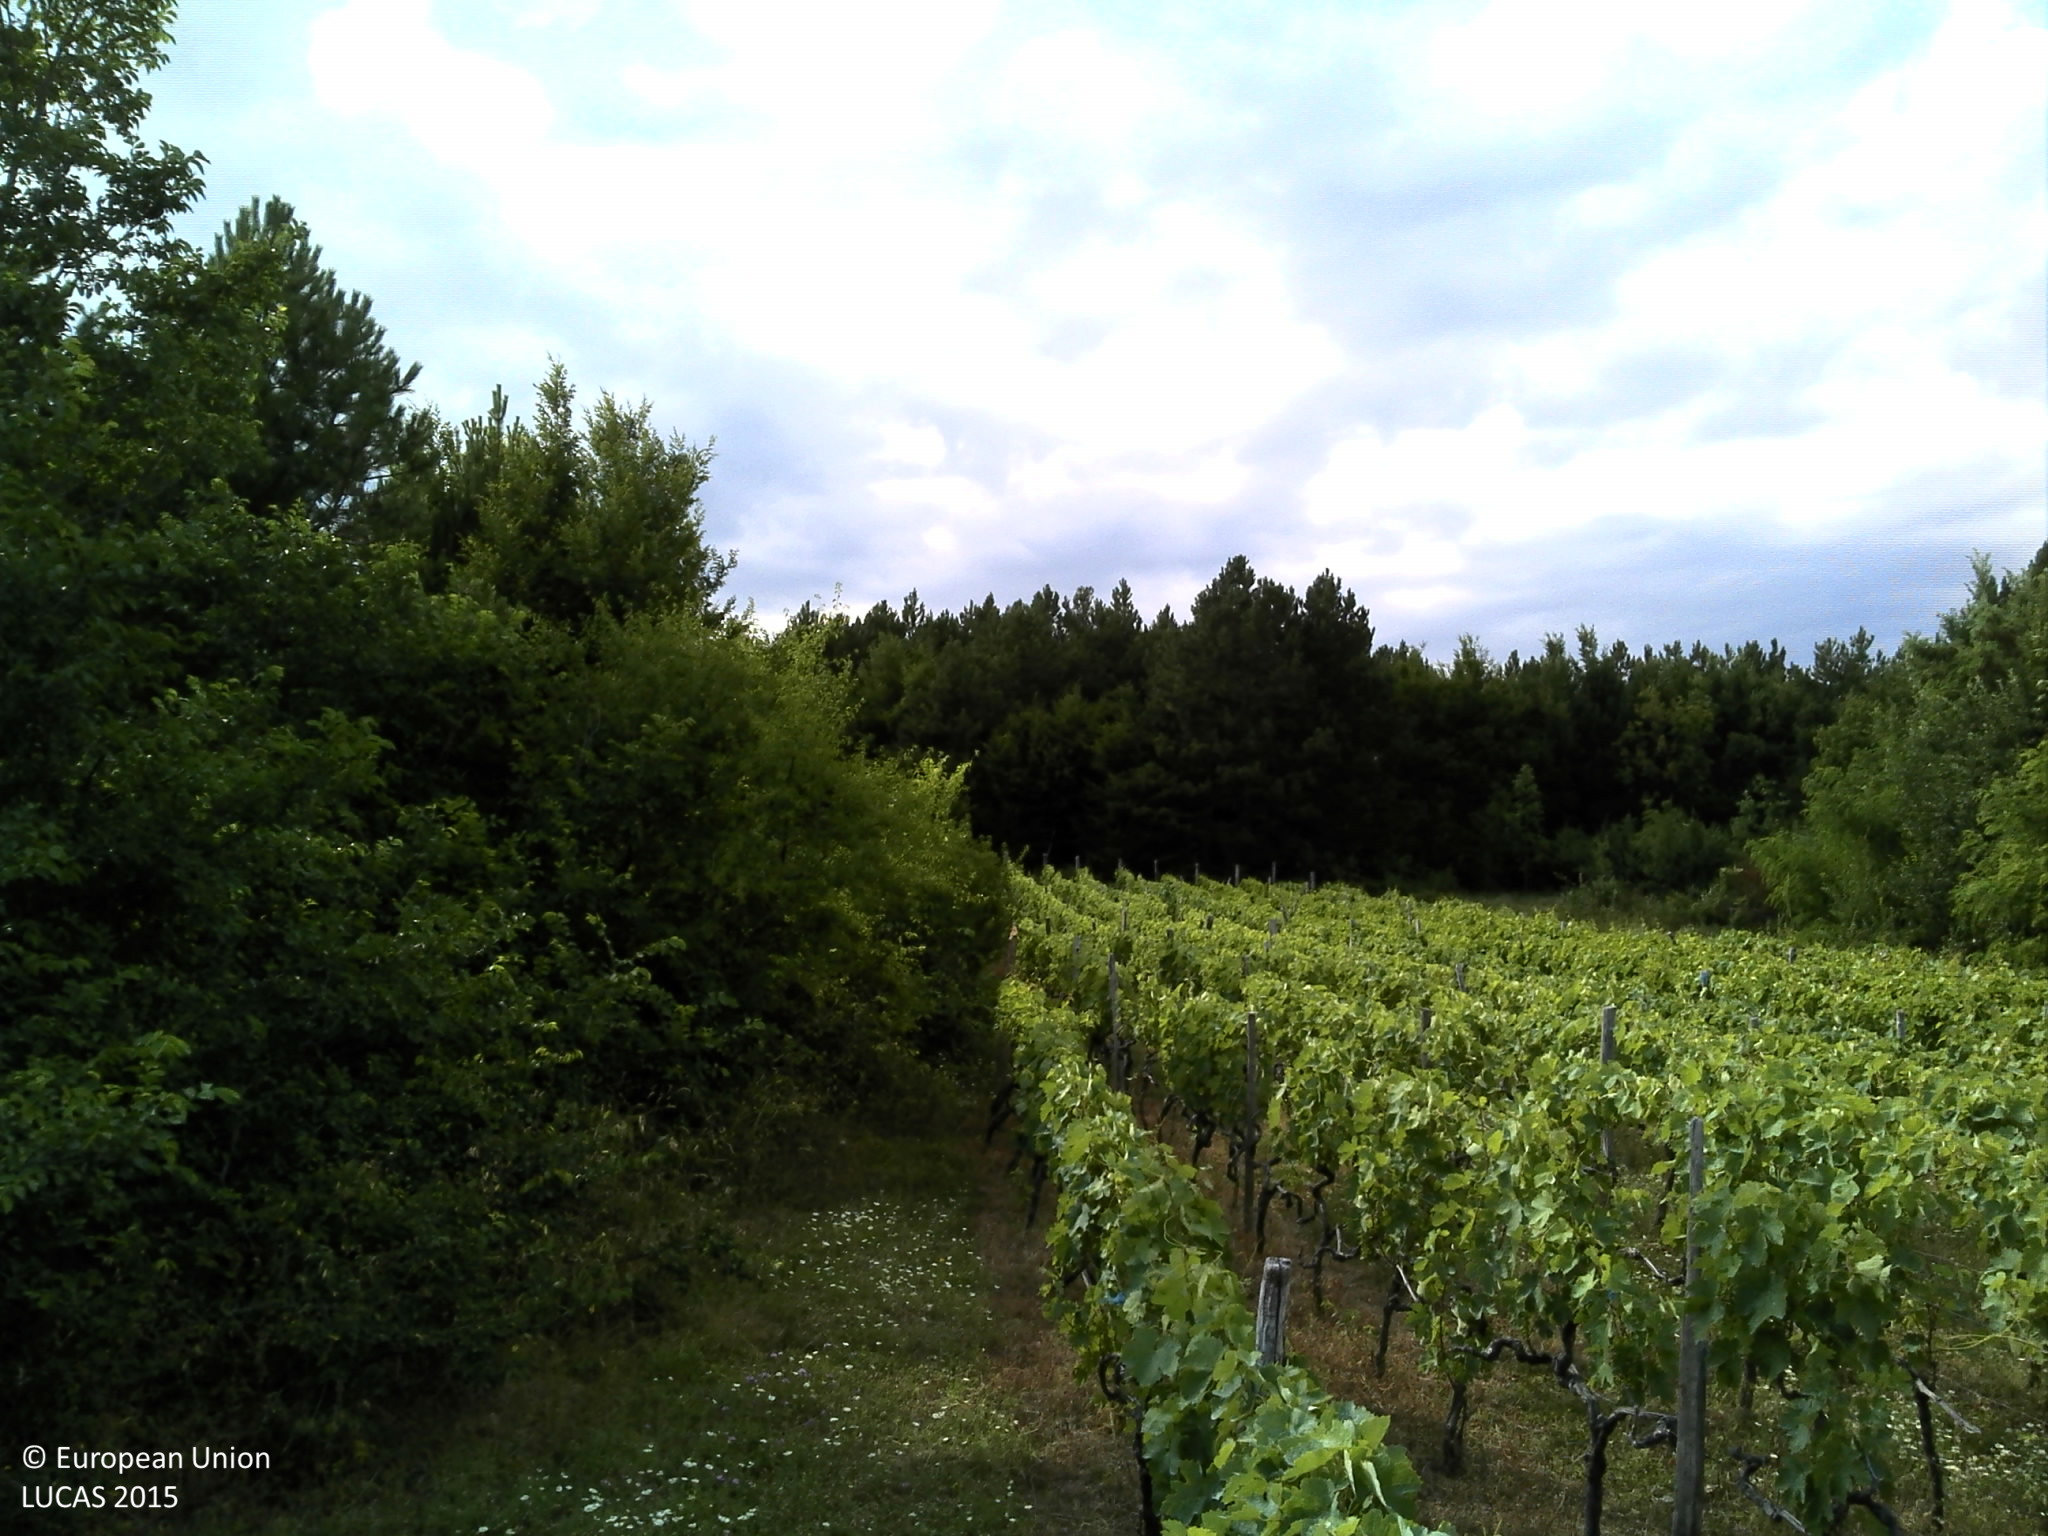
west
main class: Woodland
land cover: Broadleaved woodland
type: thermophilous deciduous forest
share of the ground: 50 - 75 %
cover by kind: broadleaved forest trees 50 %, shrubs 40 %, coniferous forest trees 10 %
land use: Semi-natural and natural areas not in use
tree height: > 5 m
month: June
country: HR
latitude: 44.0748
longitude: 16.1985
